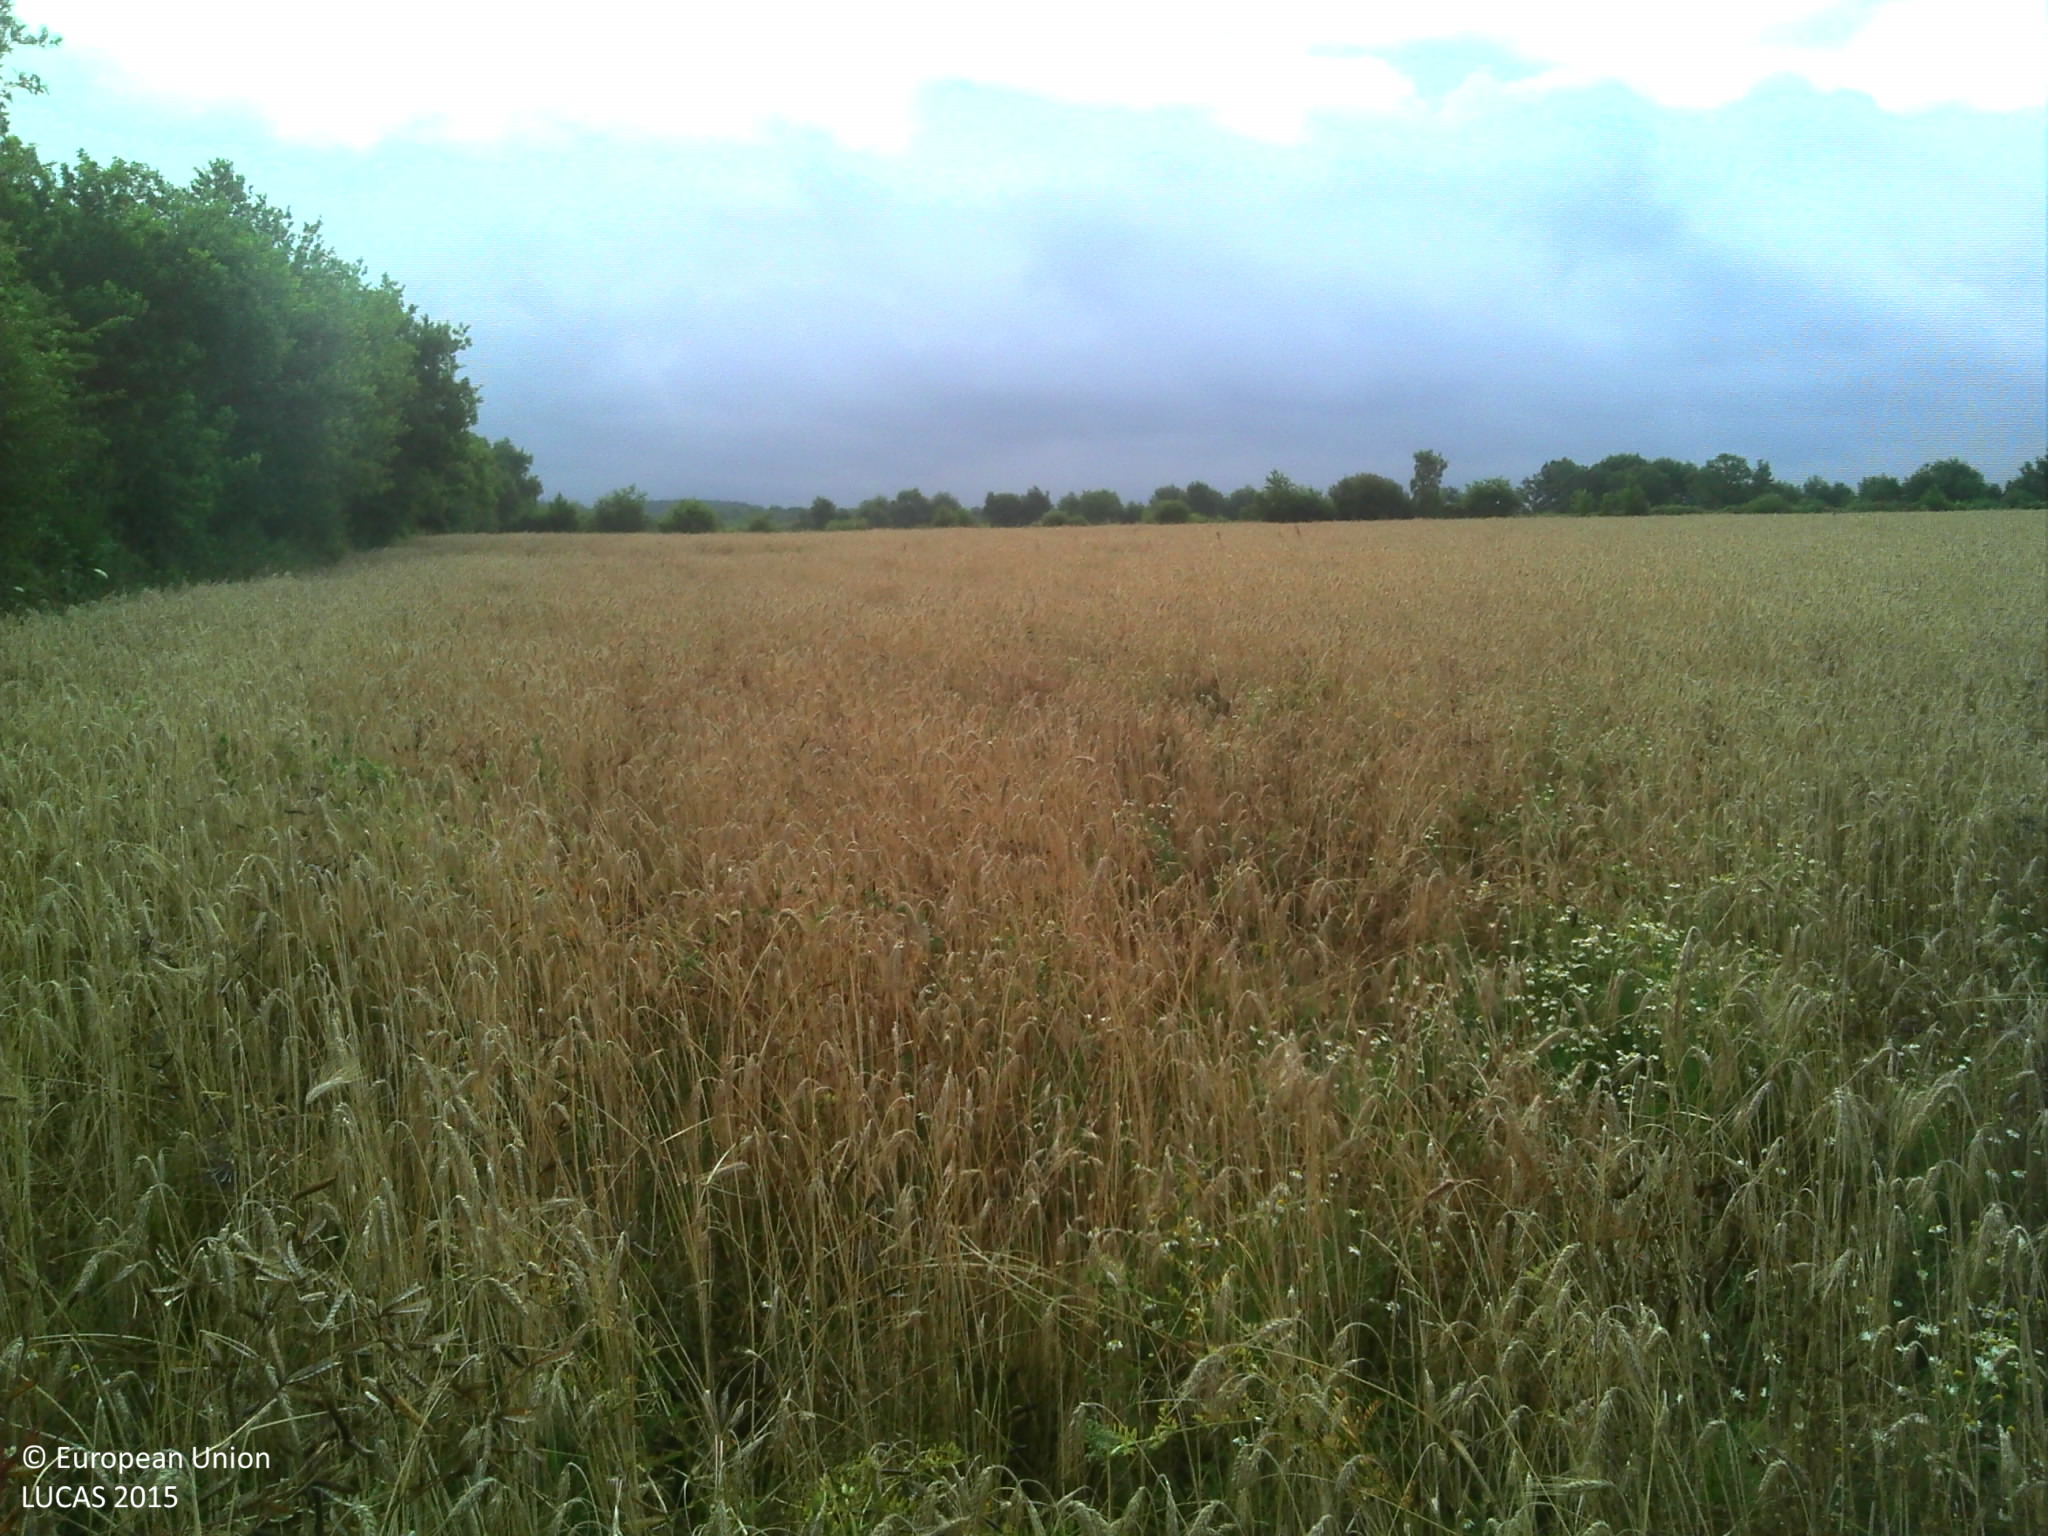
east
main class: Cropland
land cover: Common wheat
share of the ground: > 75 %
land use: Agriculture (excluding fallow land and kitchen gardens)
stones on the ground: 10 - 25 %
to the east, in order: Common wheat; Fences; Abandoned hedges; Temporary grasslands
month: July
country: FR
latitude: 47.5032
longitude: -1.9037
